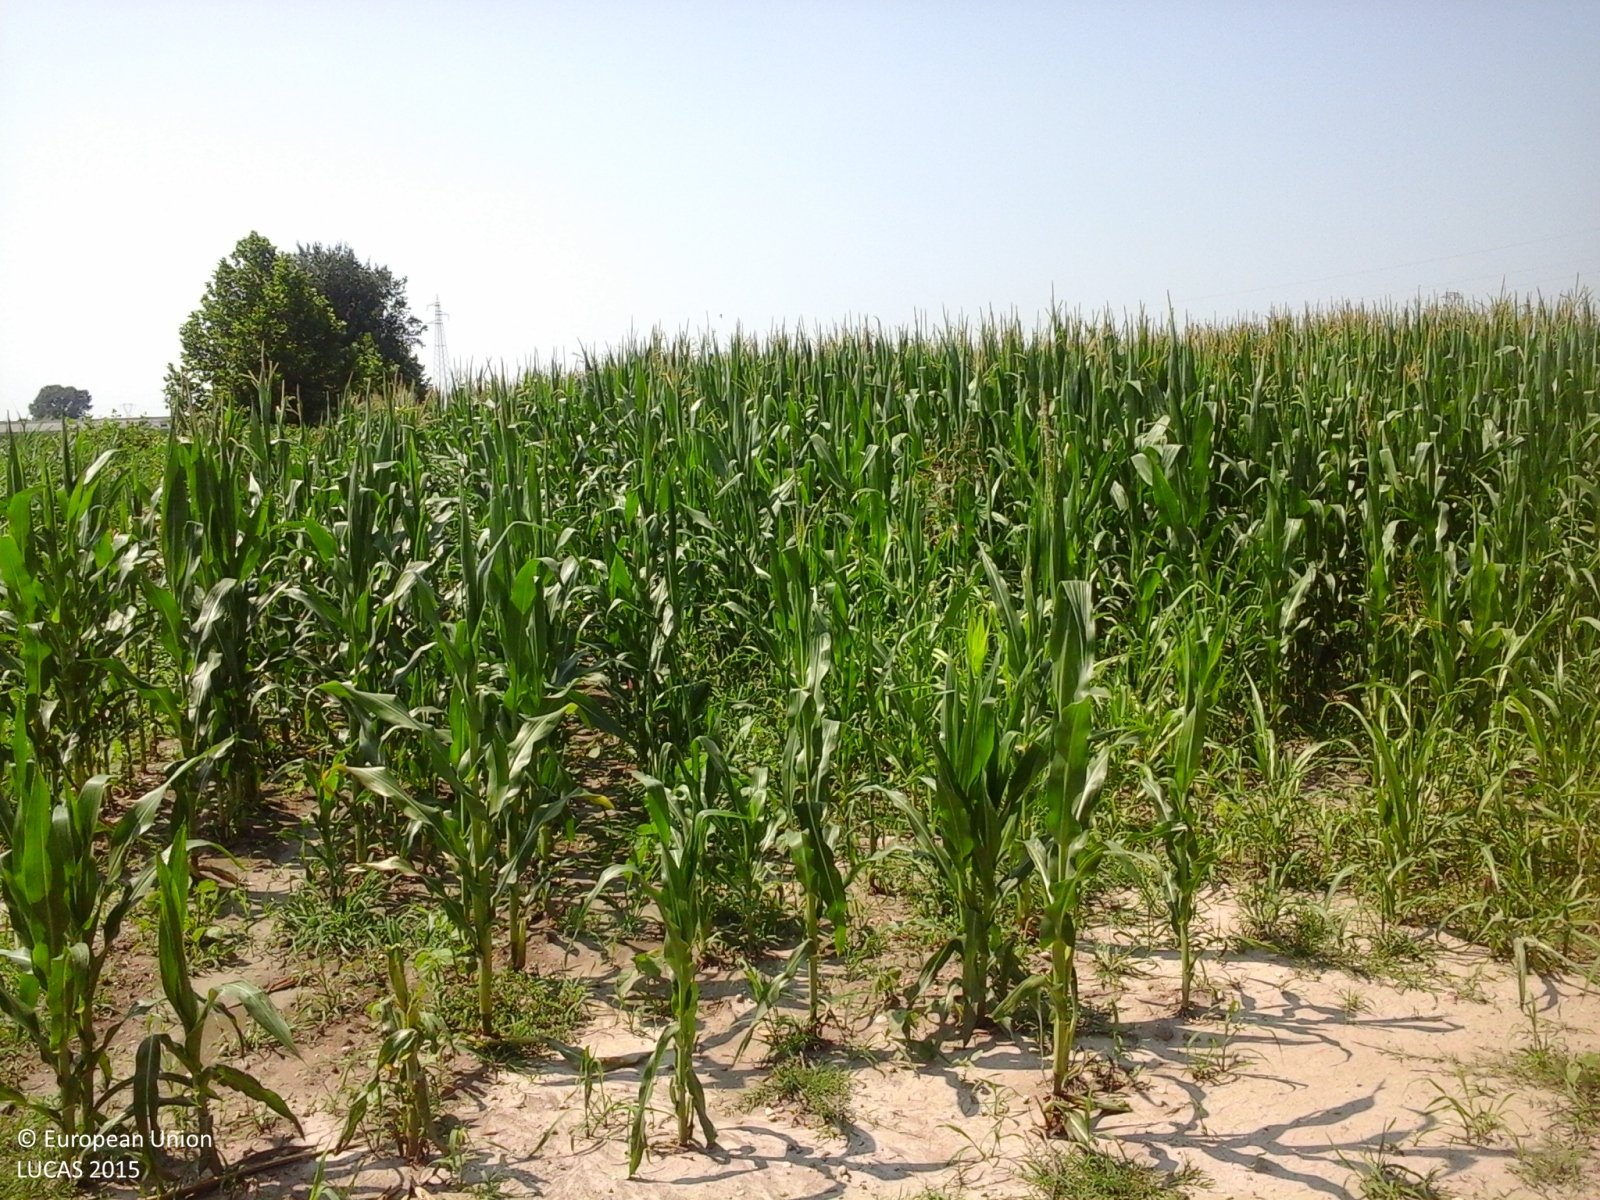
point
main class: Cropland
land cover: Maize
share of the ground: > 75 %
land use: Agriculture (excluding fallow land and kitchen gardens)
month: July
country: IT
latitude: 45.3025
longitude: 10.8784
